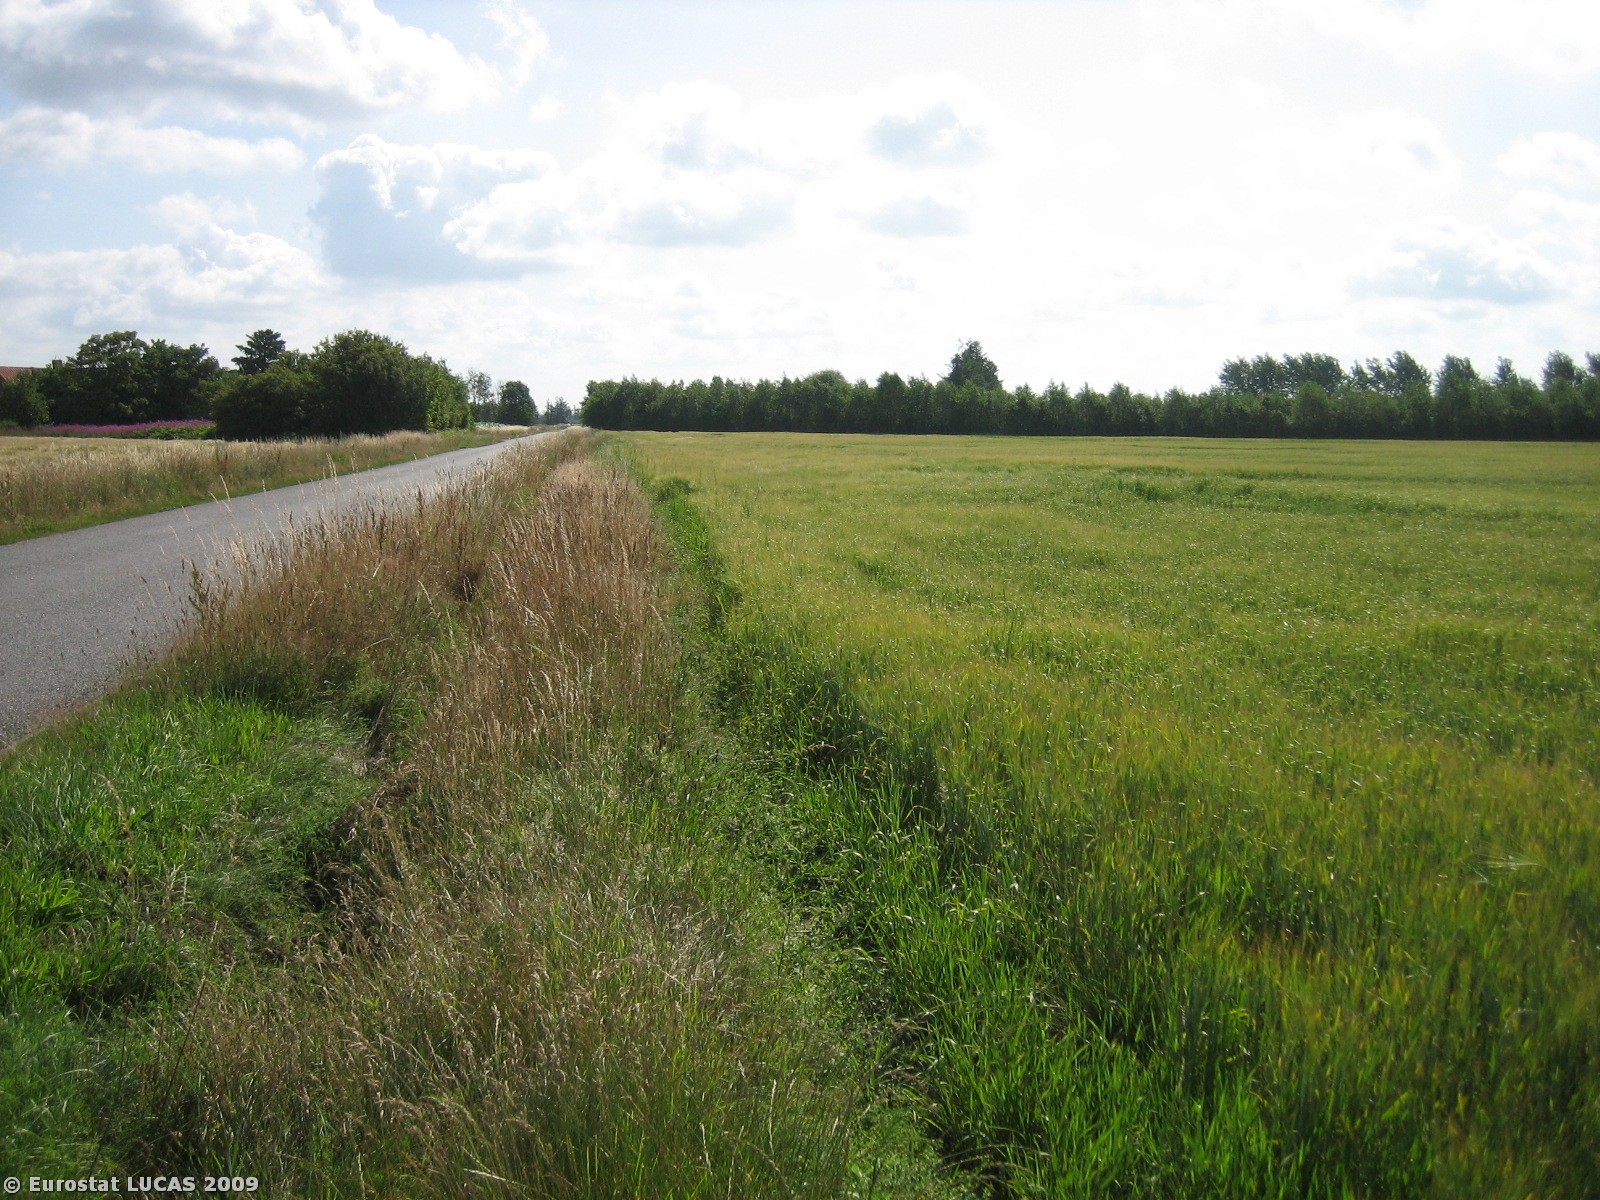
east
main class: Cropland
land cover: Barley
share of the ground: > 75 %
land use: Agriculture (excluding fallow land and kitchen gardens)
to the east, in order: Barley; Arable land (only in case pi); Barley; Broadleaved woodland; Barley
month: July
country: DK
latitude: 55.7328
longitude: 8.8068
